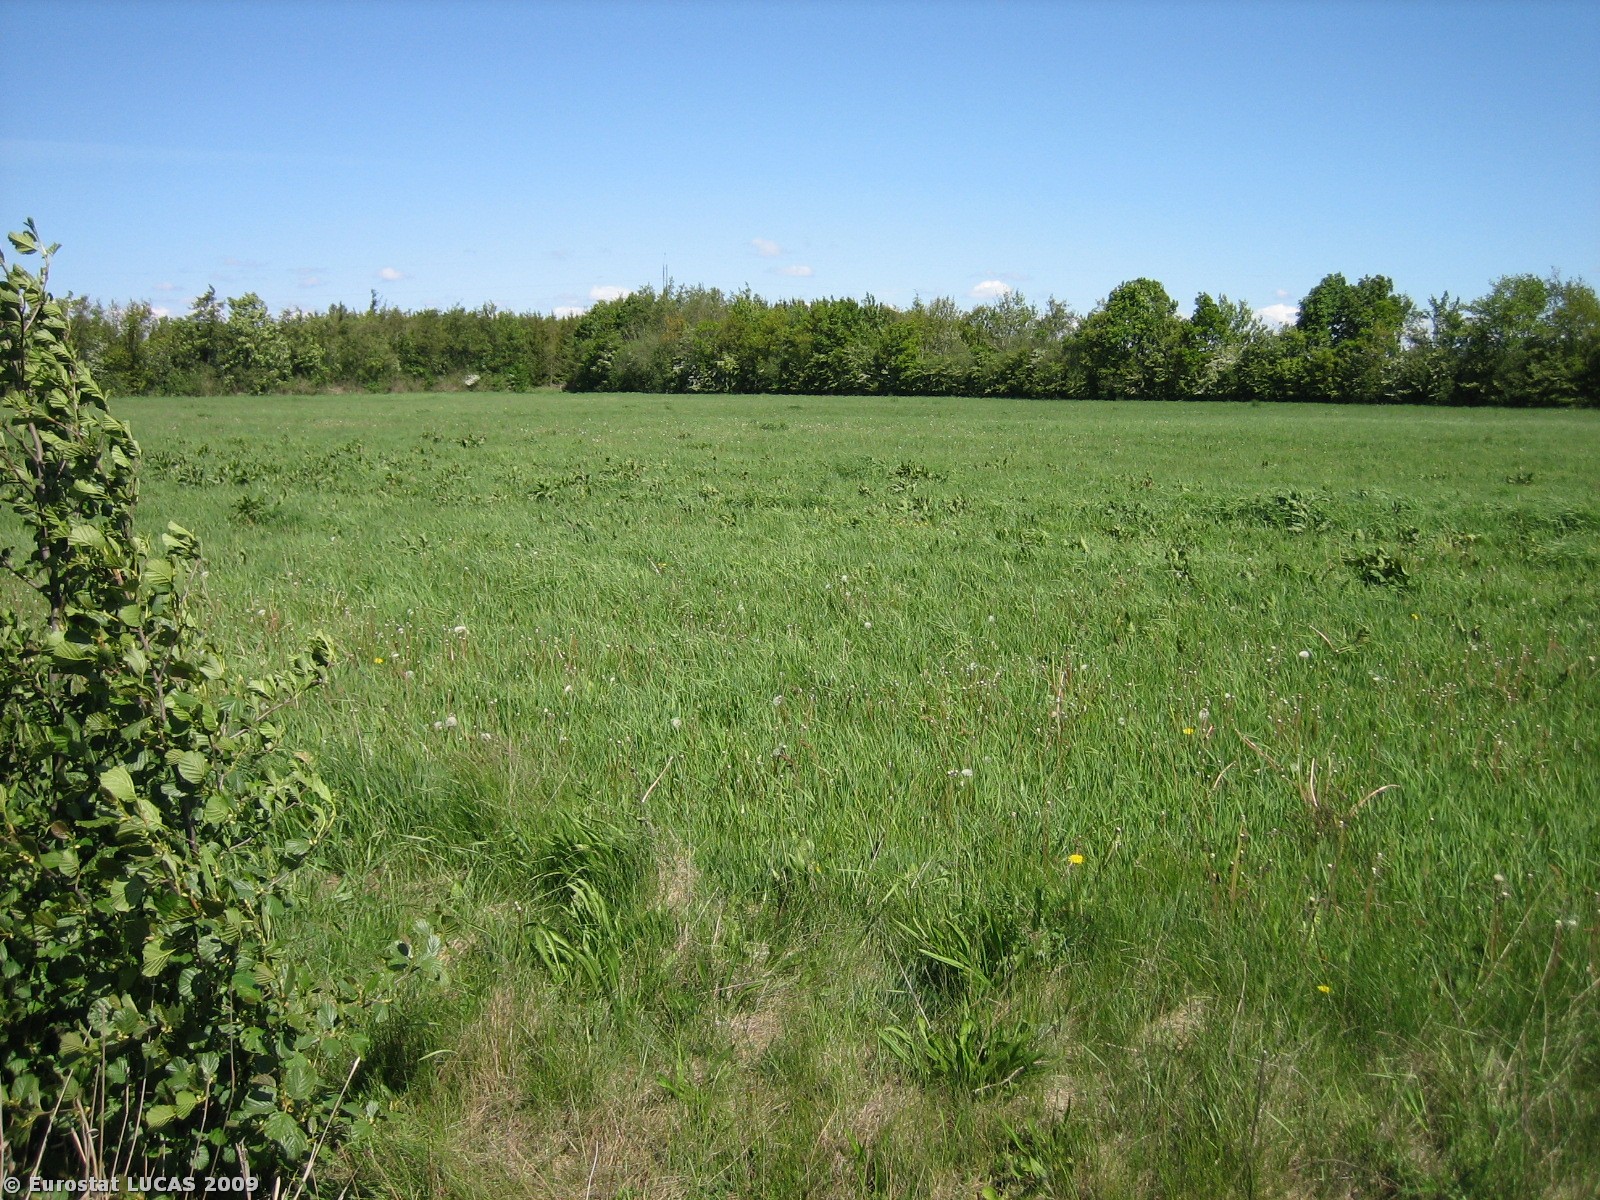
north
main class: Grassland
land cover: Grassland without tree/shrub cover
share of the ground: > 75 %
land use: Unused
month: May
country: DK
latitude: 55.9630
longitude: 8.4797
